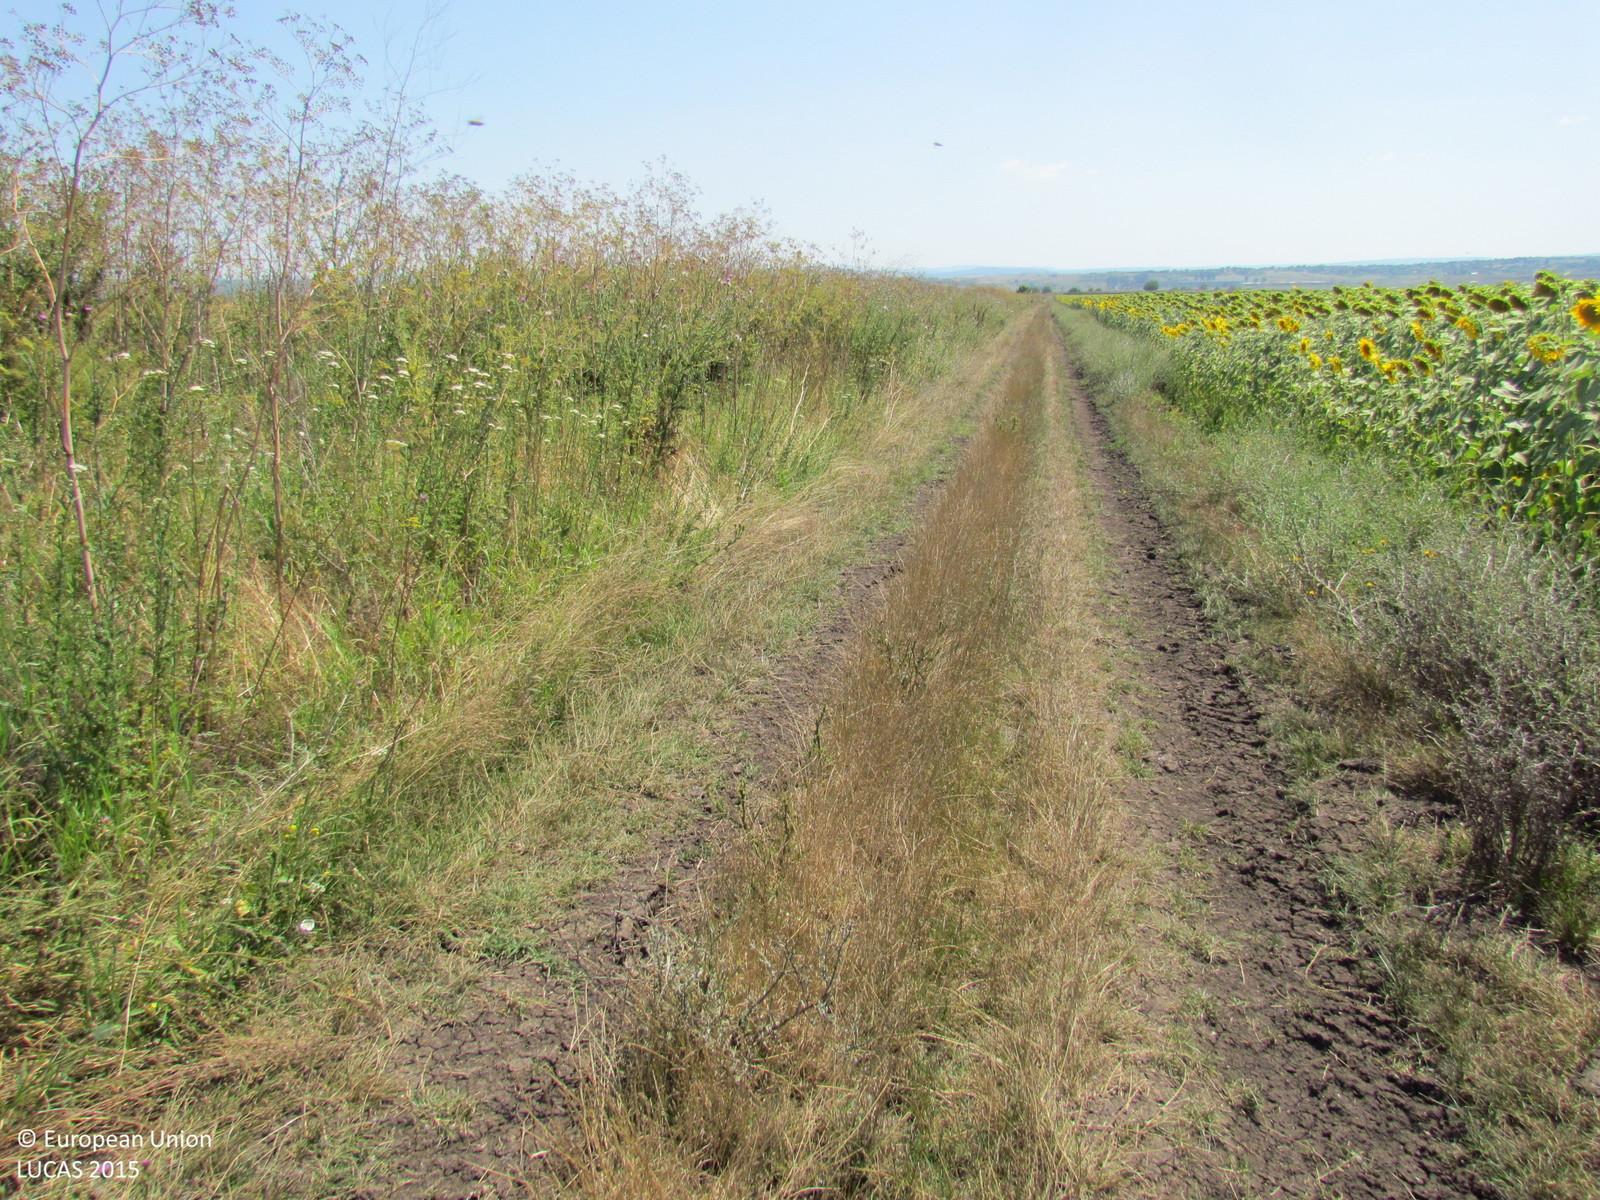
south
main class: Cropland
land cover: Sunflower
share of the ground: > 75 %
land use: Agriculture (excluding fallow land and kitchen gardens)
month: July
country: BG
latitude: 42.4260
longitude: 27.2849
